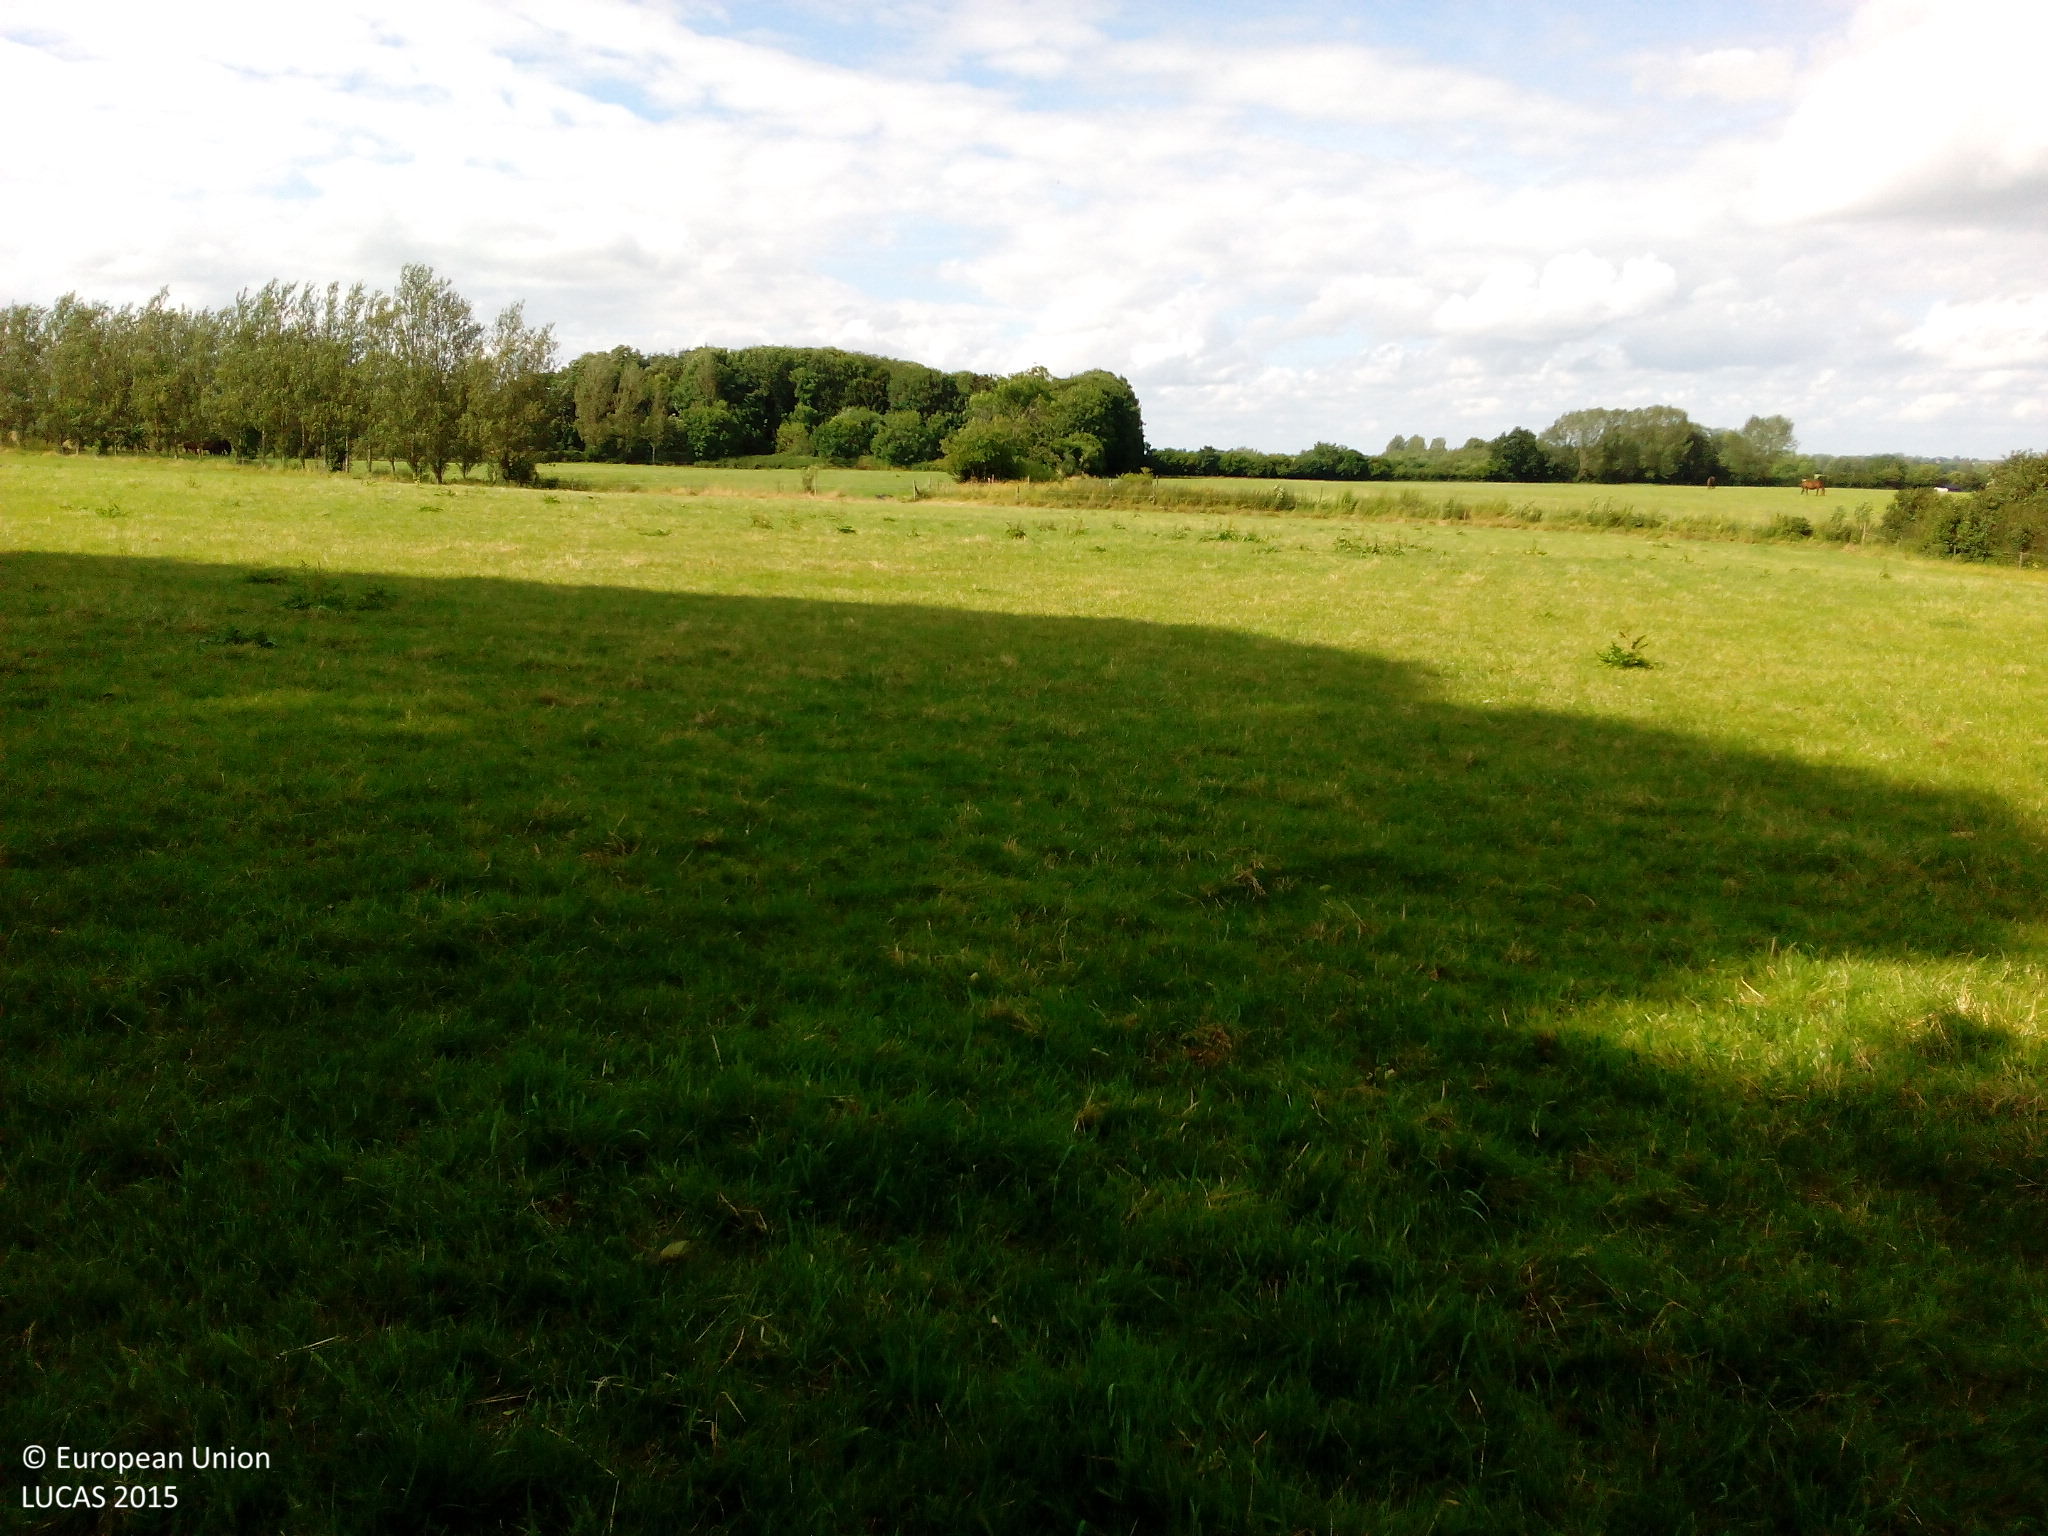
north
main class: Grassland
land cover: Grassland without tree/shrub cover
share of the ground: > 75 %
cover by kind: herbaceous plants 100 %
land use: Agriculture (excluding fallow land and kitchen gardens)
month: July
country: DK
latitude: 55.2907
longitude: 12.0299
